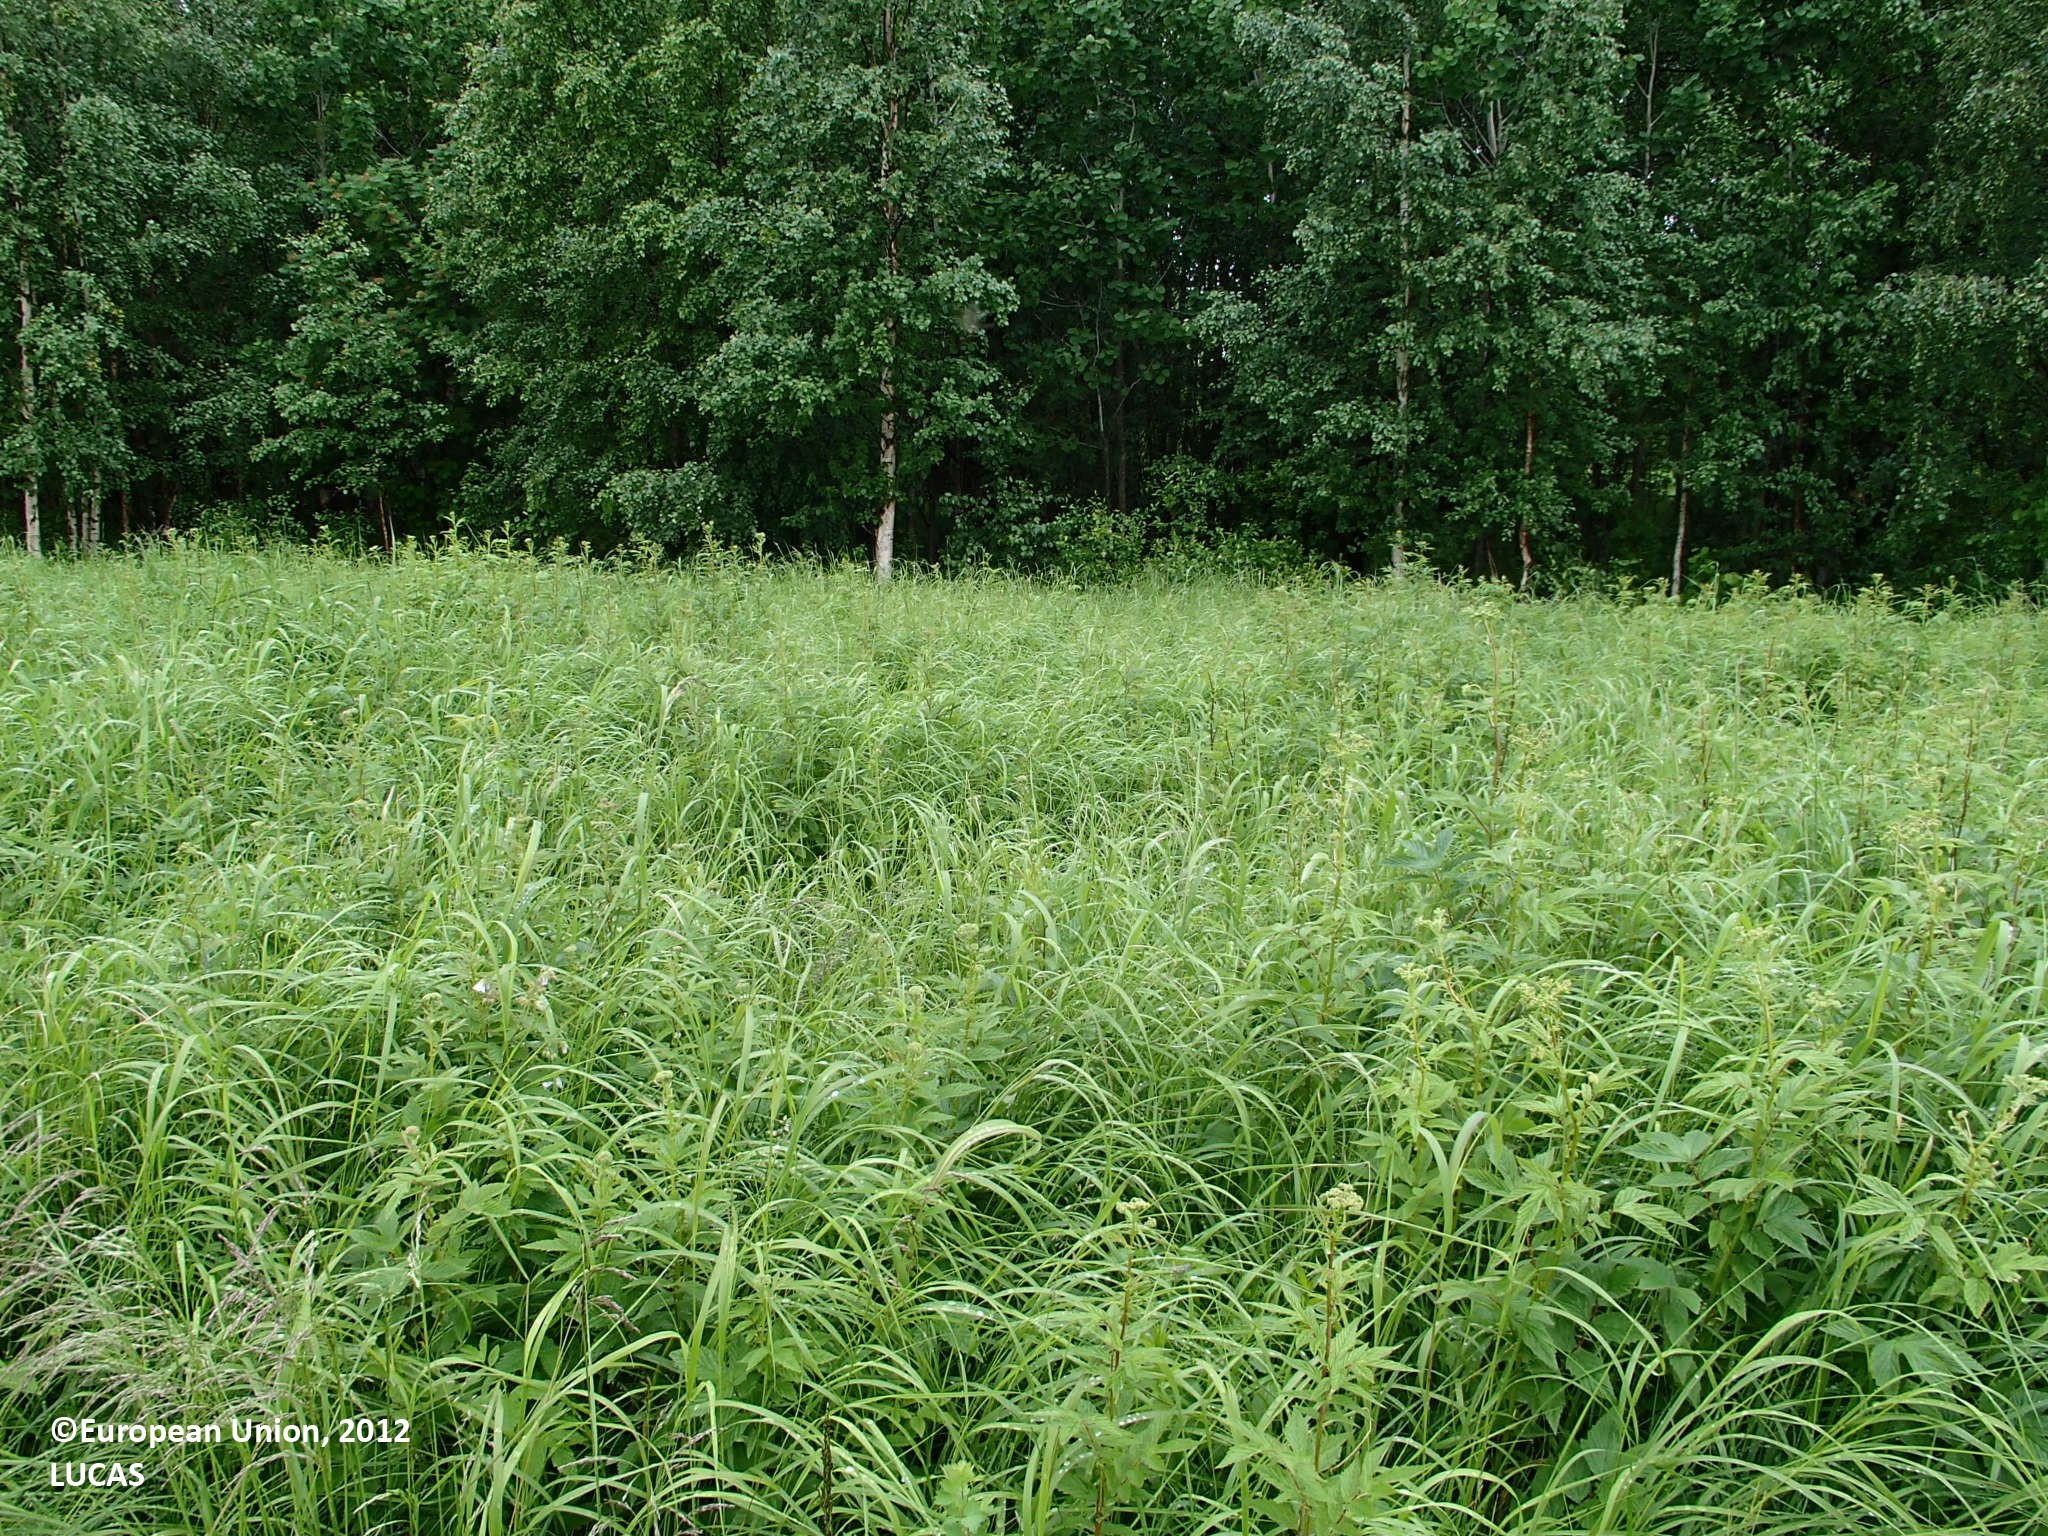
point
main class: Grassland
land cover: Grassland without tree/shrub cover
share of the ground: > 75 %
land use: Amenities, museums, leisure
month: July
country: FI
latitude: 66.9875
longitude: 27.5522
